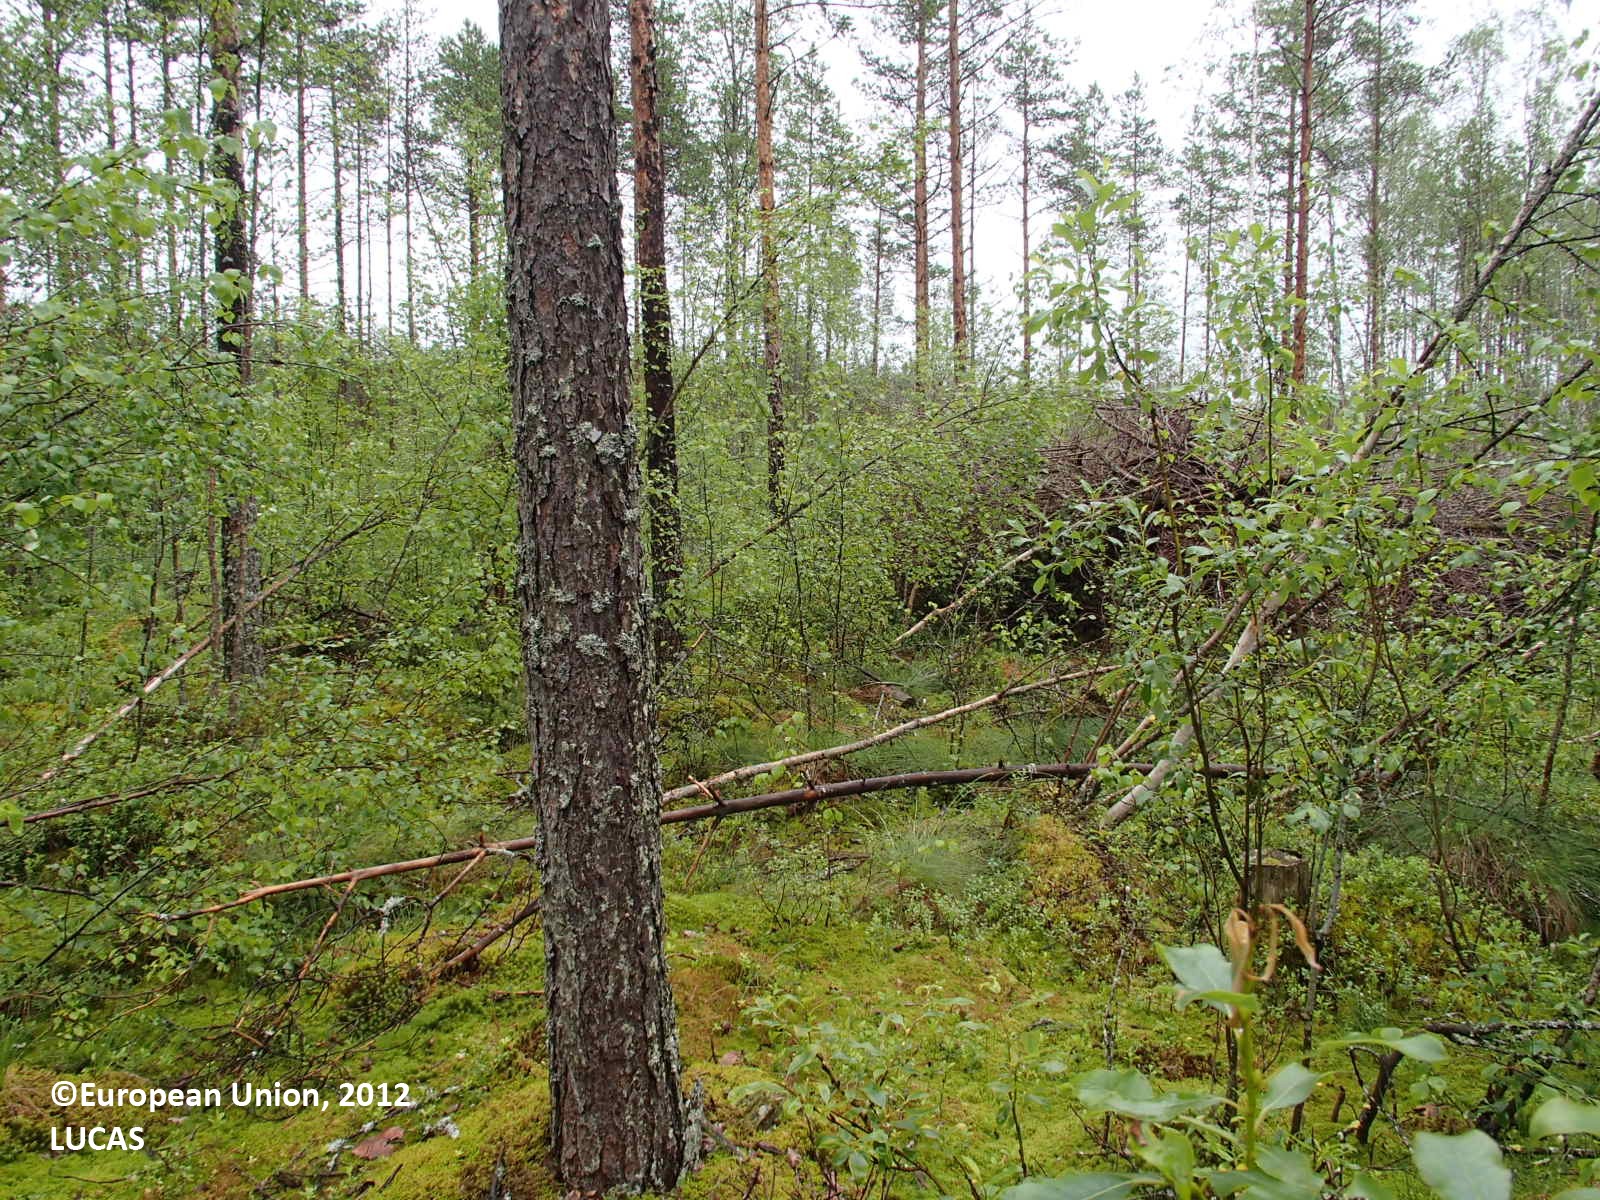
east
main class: Woodland
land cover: Pine dominated mixed woodland
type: boreal forest
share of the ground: > 75 %
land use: Forestry
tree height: > 5 m
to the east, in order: Pine dominated mixed woodland; Ditches and canals; Pine dominated mixed woodland; Broadleaved woodland; Pine dominated mixed woodland; Other bare soil; Pine dominated mixed woodland; Ditches and canals; Pine dominated mixed woodland; Ditches and canals; Pine dominated mixed woodland
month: July
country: FI
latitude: 64.3939
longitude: 26.3499
